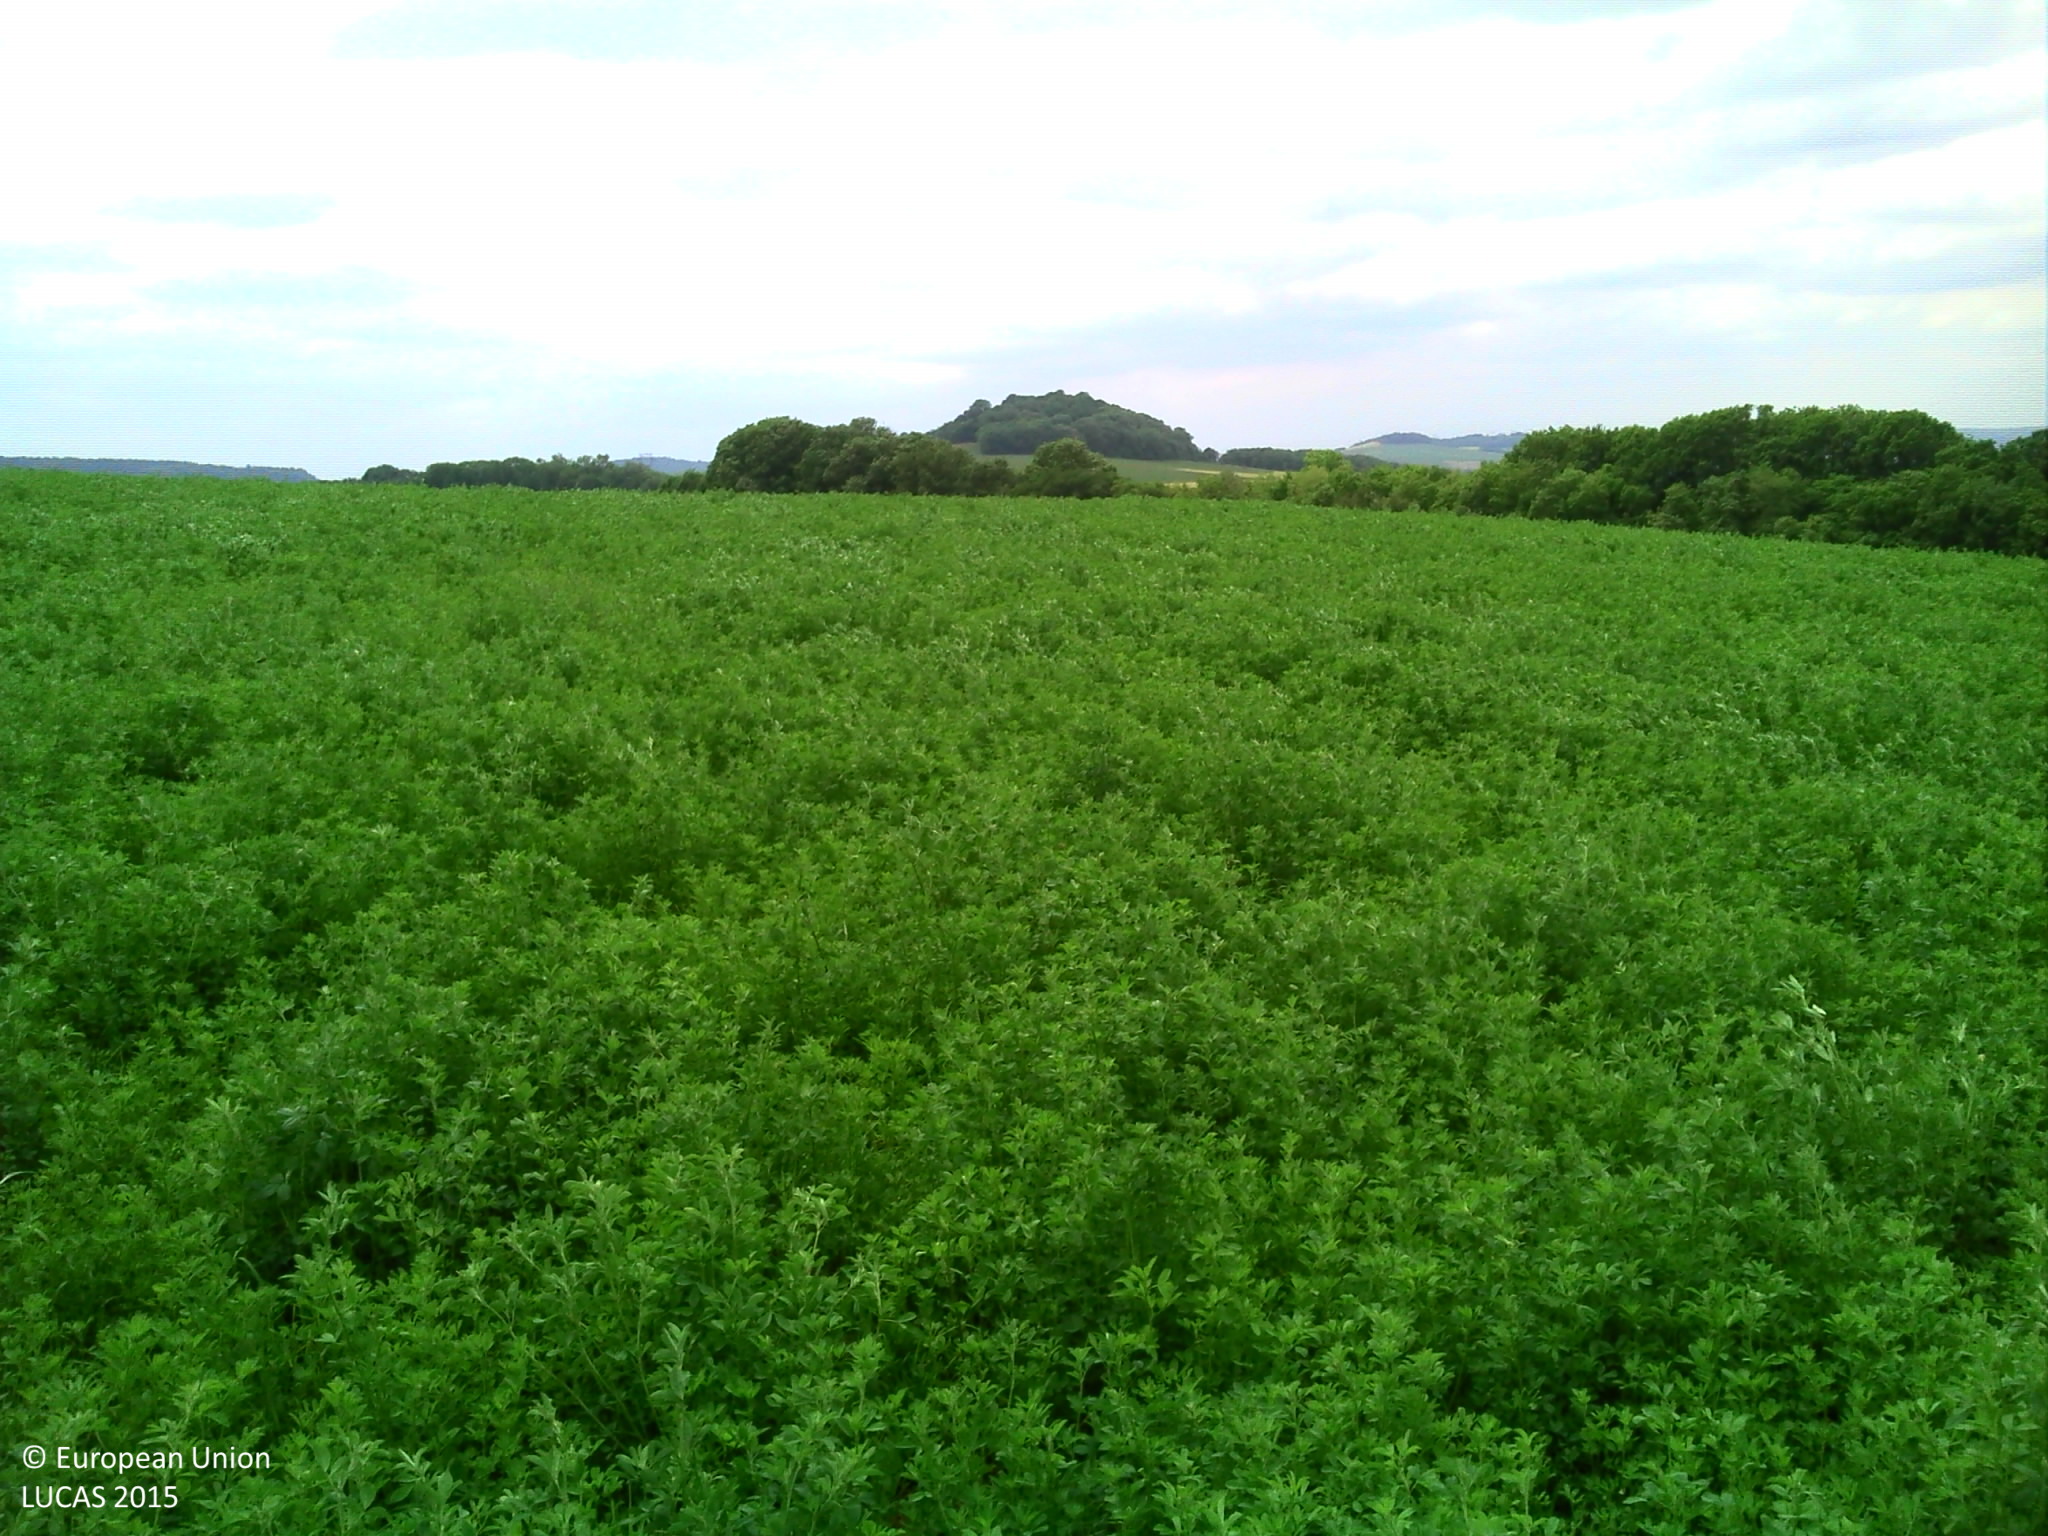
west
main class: Cropland
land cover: Lucerne
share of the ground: > 75 %
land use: Agriculture (excluding fallow land and kitchen gardens)
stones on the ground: 25 - 50 %
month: June
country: FR
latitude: 48.8434
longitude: 6.2255
